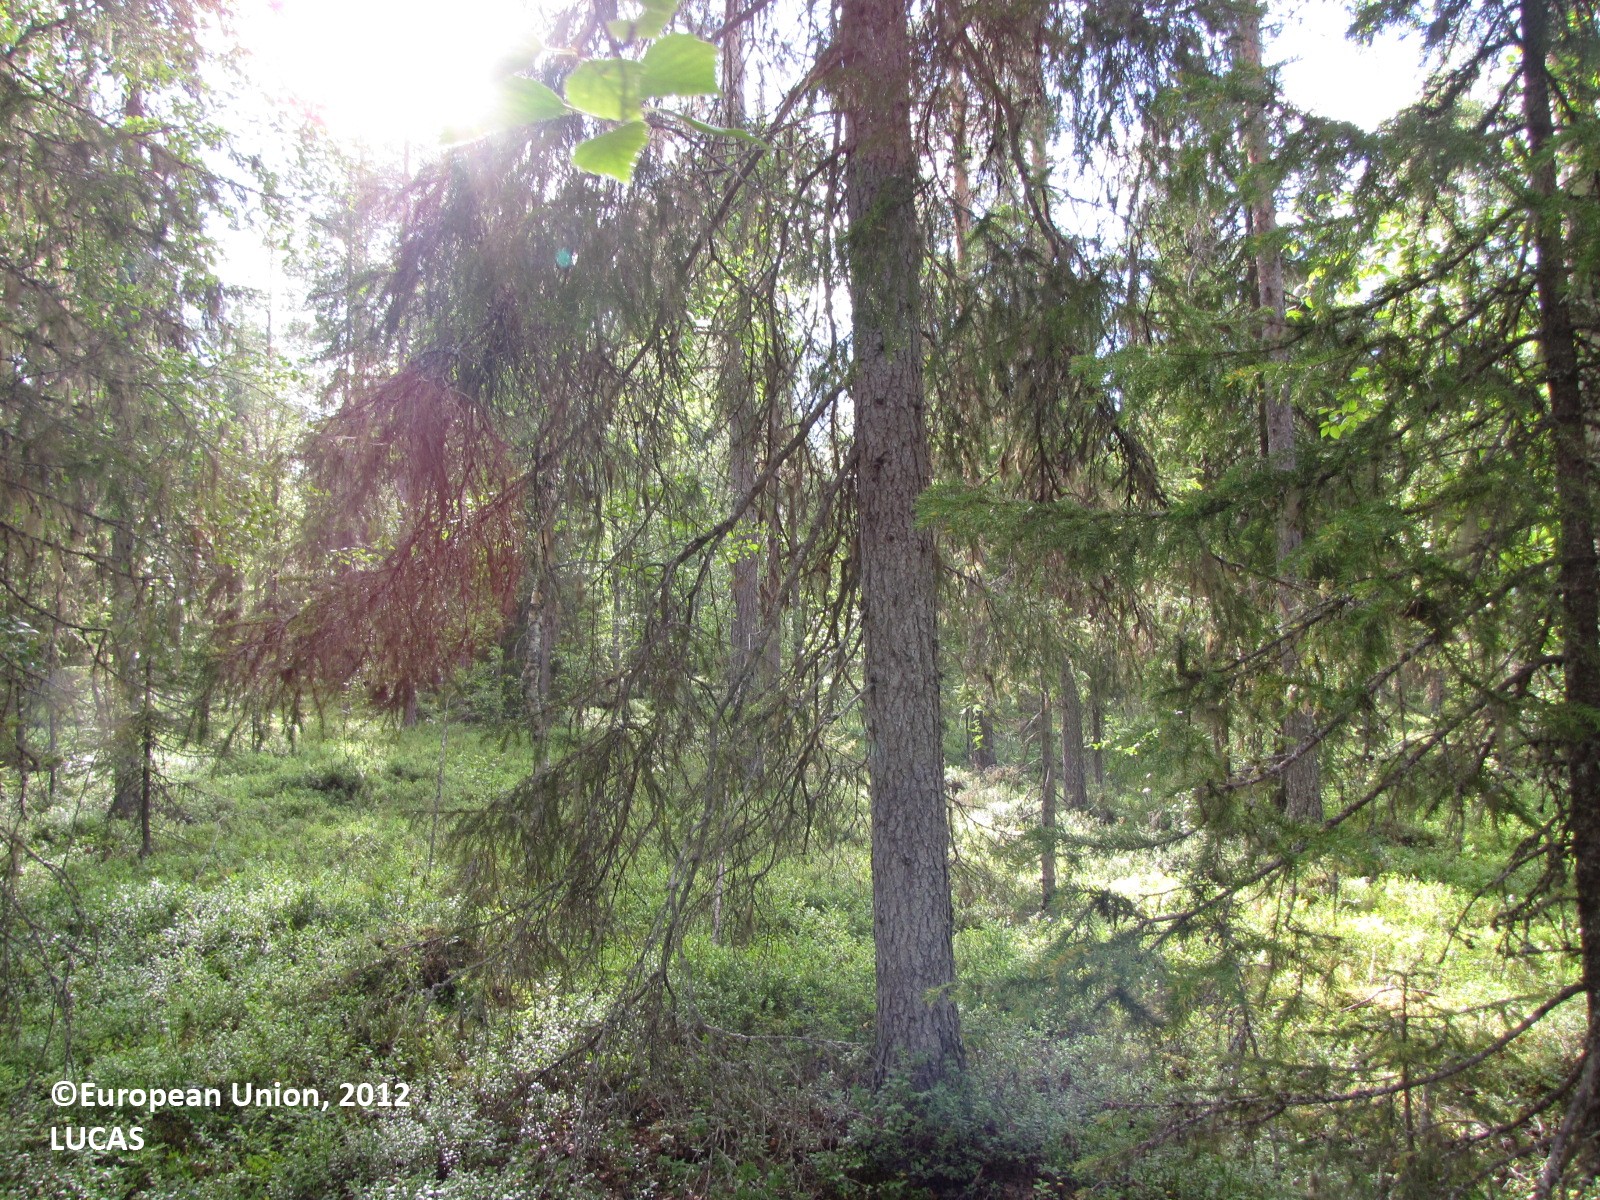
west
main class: Woodland
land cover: Other coniferous woodland
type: boreal forest
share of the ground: 25 - 50 %
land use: Forestry
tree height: > 5 m
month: August
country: FI
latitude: 66.8626
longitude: 25.1724
